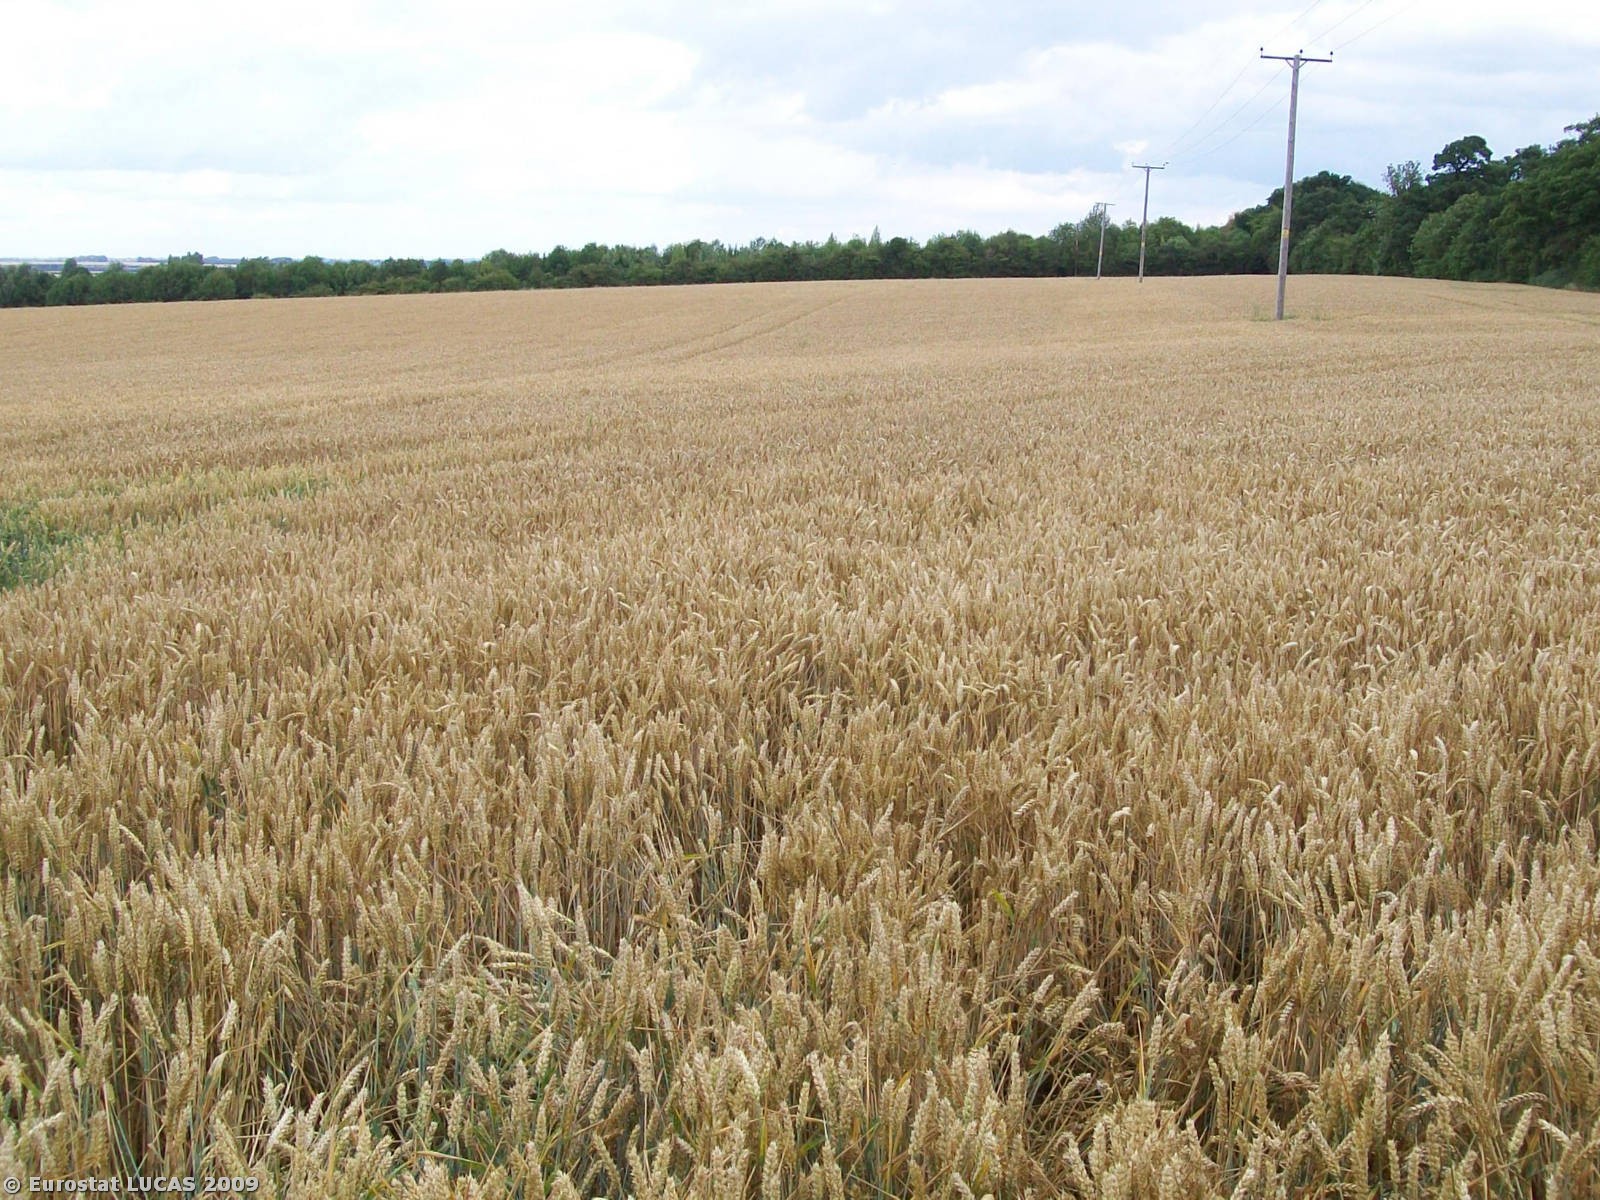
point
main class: Cropland
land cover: Common wheat
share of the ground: > 75 %
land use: Agriculture (excluding fallow land and kitchen gardens)
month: July
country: GB
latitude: 52.2460
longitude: 0.0227
